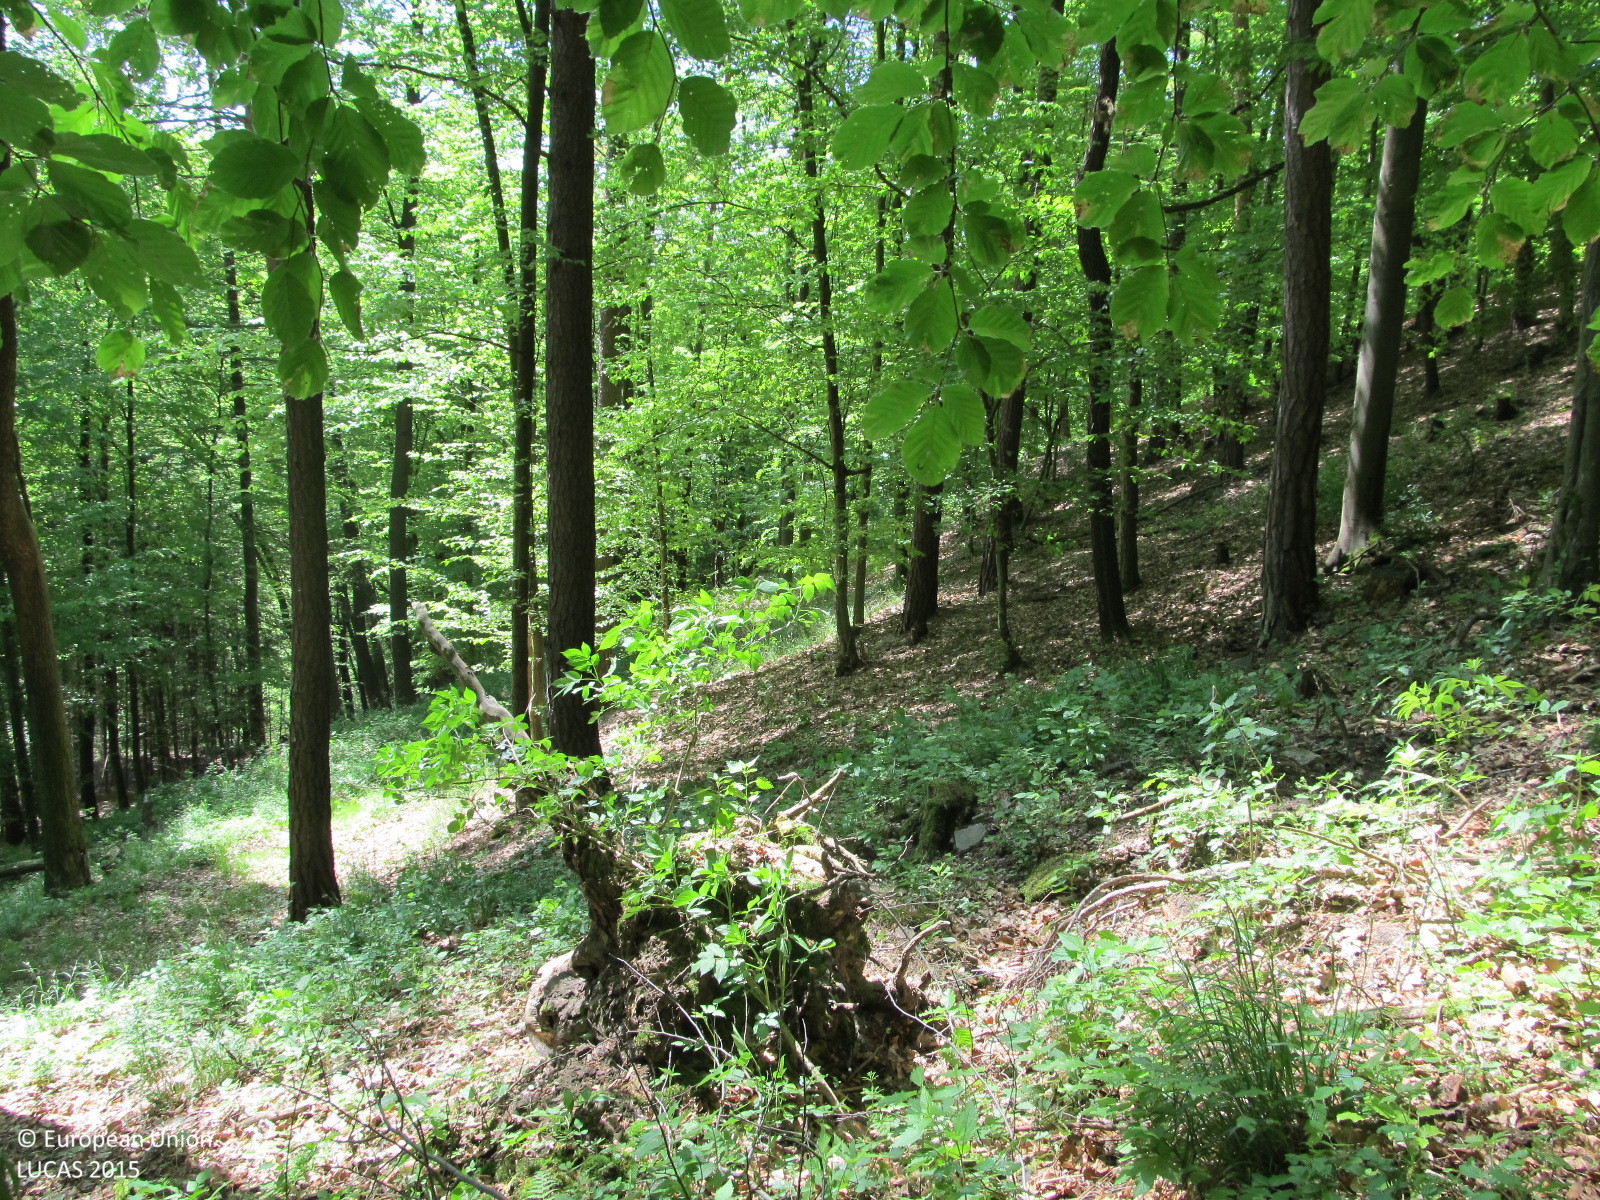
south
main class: Woodland
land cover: Pine dominated mixed woodland
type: beech forest
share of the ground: > 75 %
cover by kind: broadleaved forest trees 60 %, coniferous forest trees 20 %, herbaceous plants 10 %, shrubs 5 %, unconsolidated bare surface 5 %
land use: Forestry
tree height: > 5 m
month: May
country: AT
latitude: 48.5019
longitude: 15.4841
